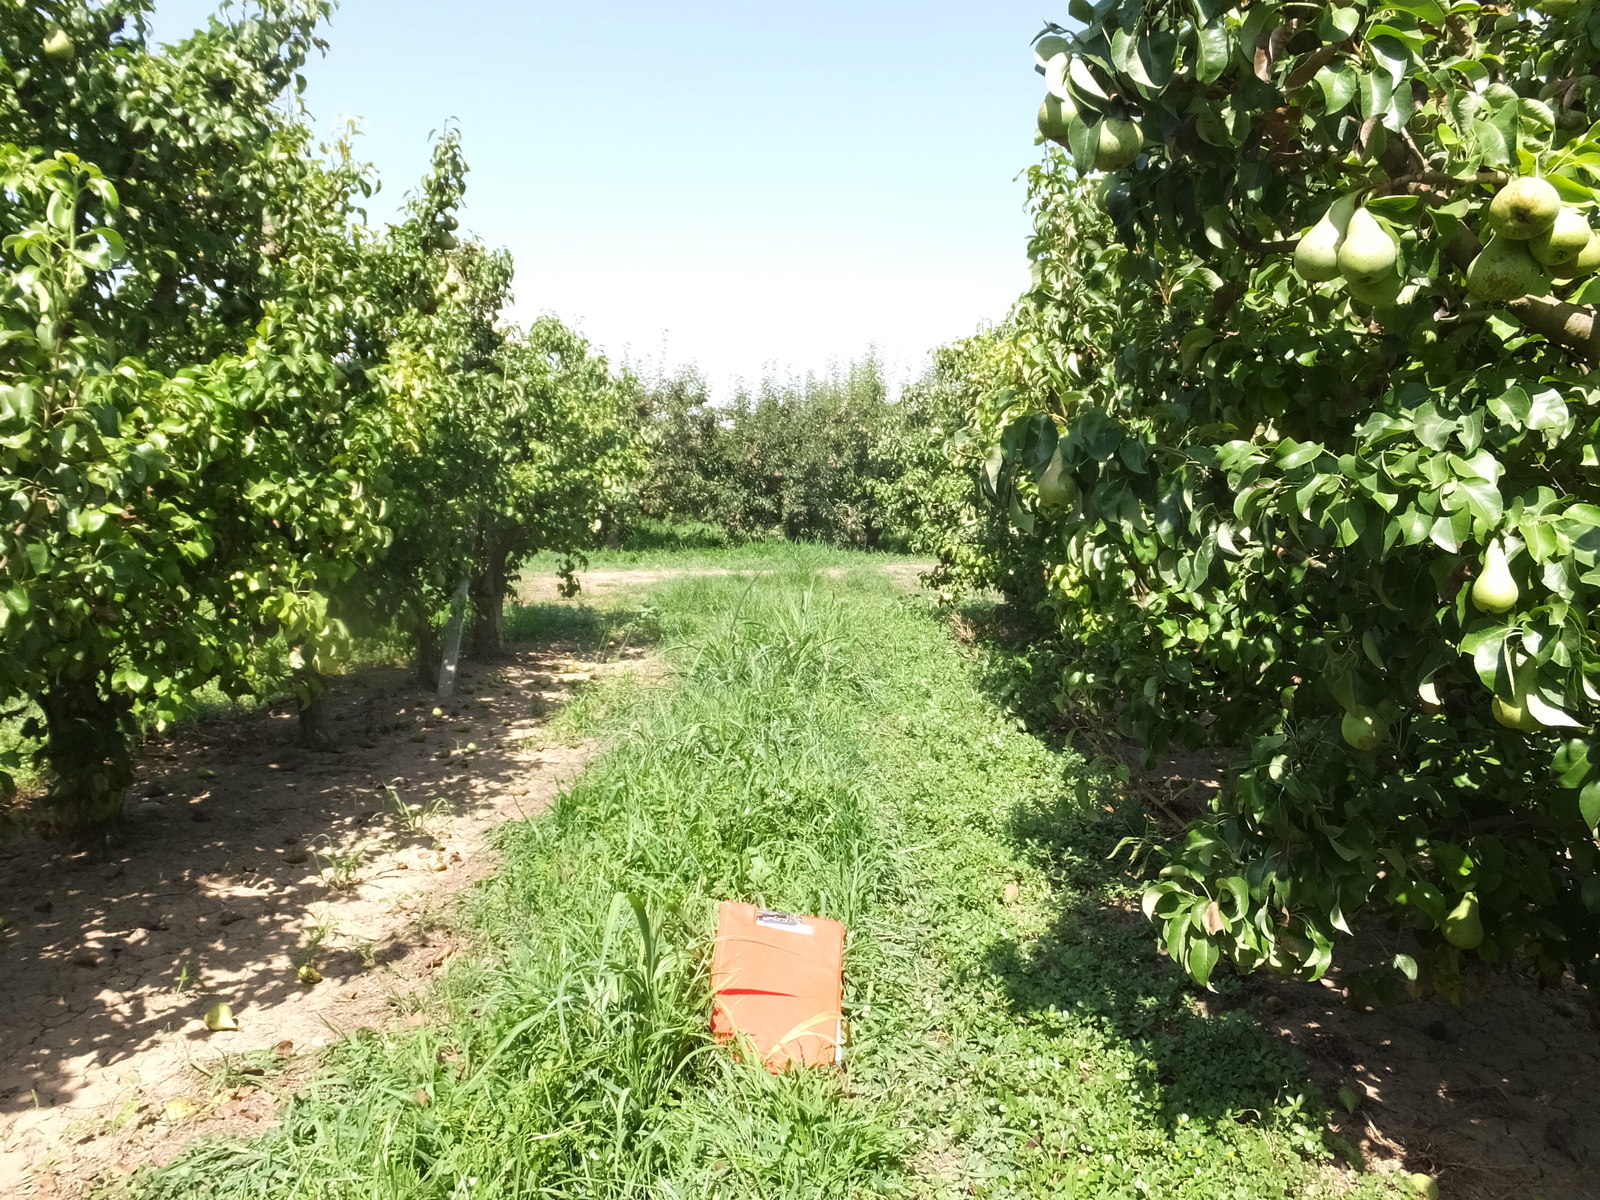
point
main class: Cropland
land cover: Pear fruit
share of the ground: > 75 %
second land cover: Spontaneously vegetated surfaces
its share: 25 - 50 %
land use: Agriculture (excluding fallow land and kitchen gardens)
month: July
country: ES
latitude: 41.4943
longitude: 0.4651
